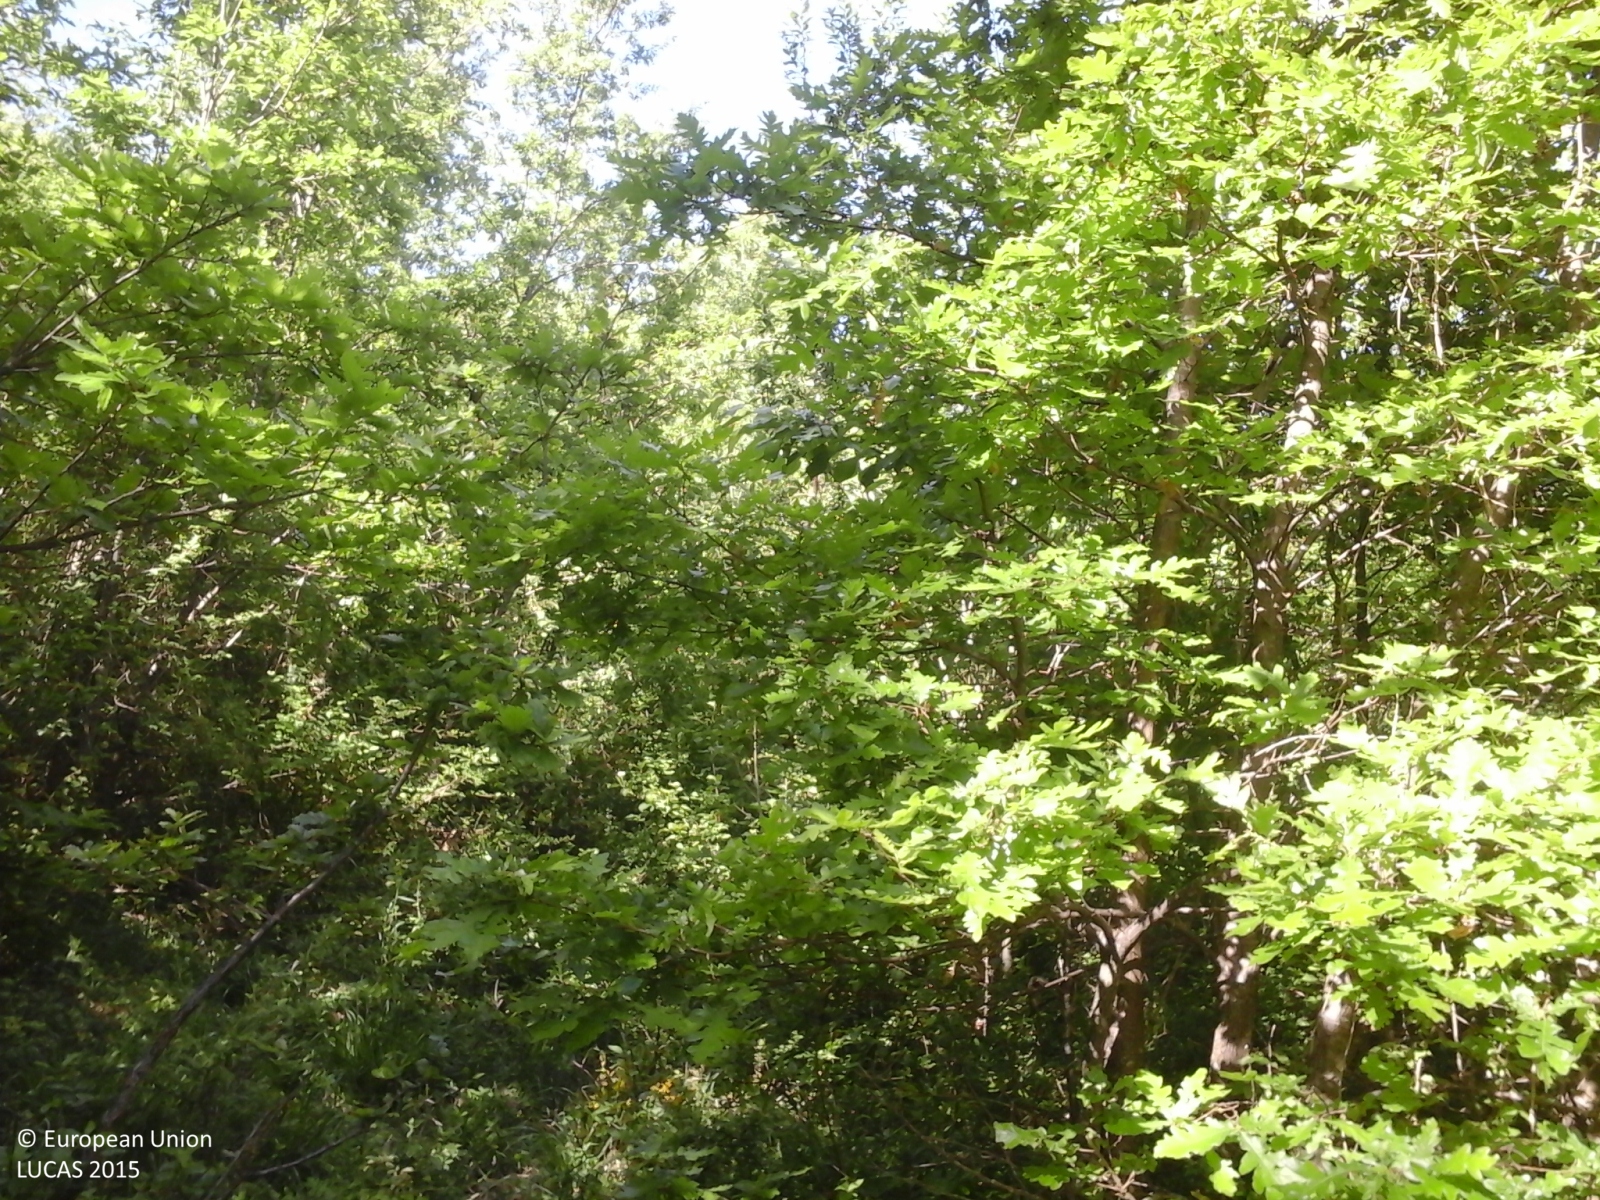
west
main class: Woodland
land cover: Broadleaved woodland
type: mesophytic deciduous forest
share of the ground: > 75 %
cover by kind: broadleaved forest trees 90 %, shrubs 5 %, herbaceous plants 5 %
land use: Forestry
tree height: > 5 m
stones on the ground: < 10 %
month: May
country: IT
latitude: 44.4582
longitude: 9.6614
